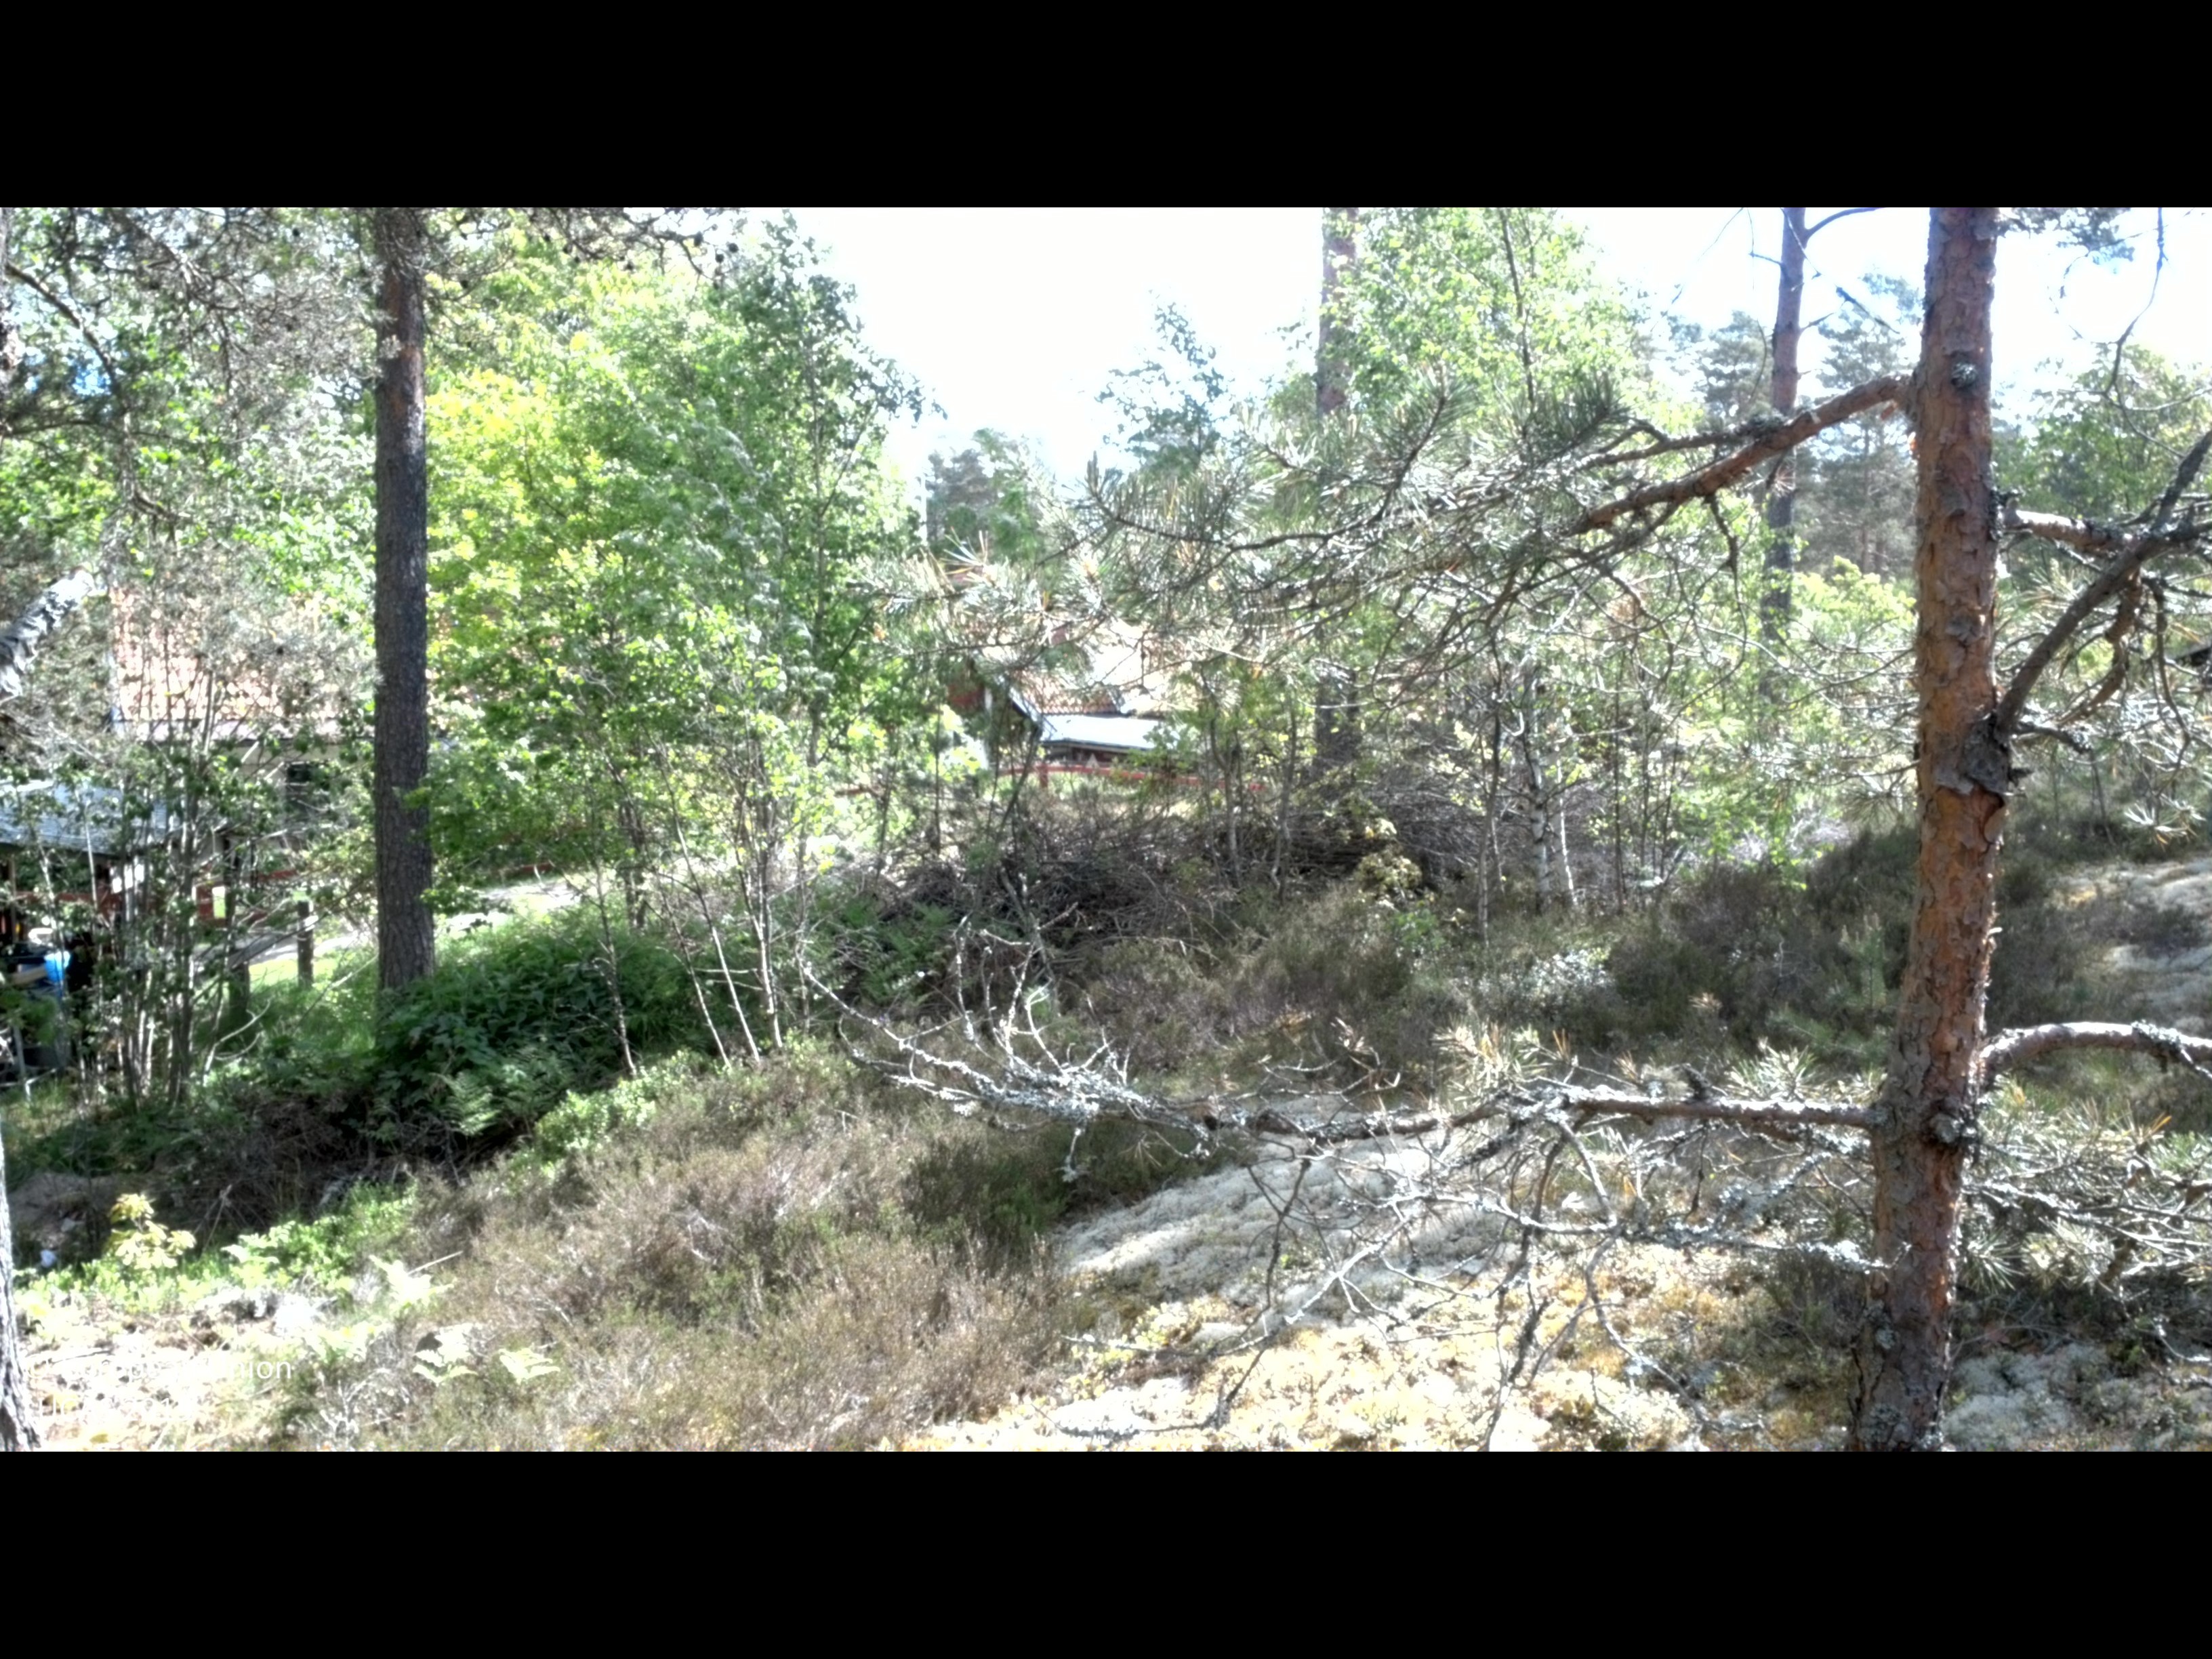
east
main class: Woodland
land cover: Pine dominated coniferous woodland
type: boreal forest
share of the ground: 50 - 75 %
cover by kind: coniferous forest trees 65 %, shrubs 15 %, lichens and mosses 15 %, broadleaved forest trees 5 %
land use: Forestry
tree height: > 5 m
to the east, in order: Pine dominated coniferous woodland; Artificial constructions in urban areas; Pine dominated coniferous woodland; Paved roads, cycling and walking lanes; Pine dominated mixed woodland; Pine dominated coniferous woodland; Electric lines; Pine dominated coniferous woodland; Electric lines; Pine dominated coniferous woodland
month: May
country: SE
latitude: 57.5340
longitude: 16.5970
